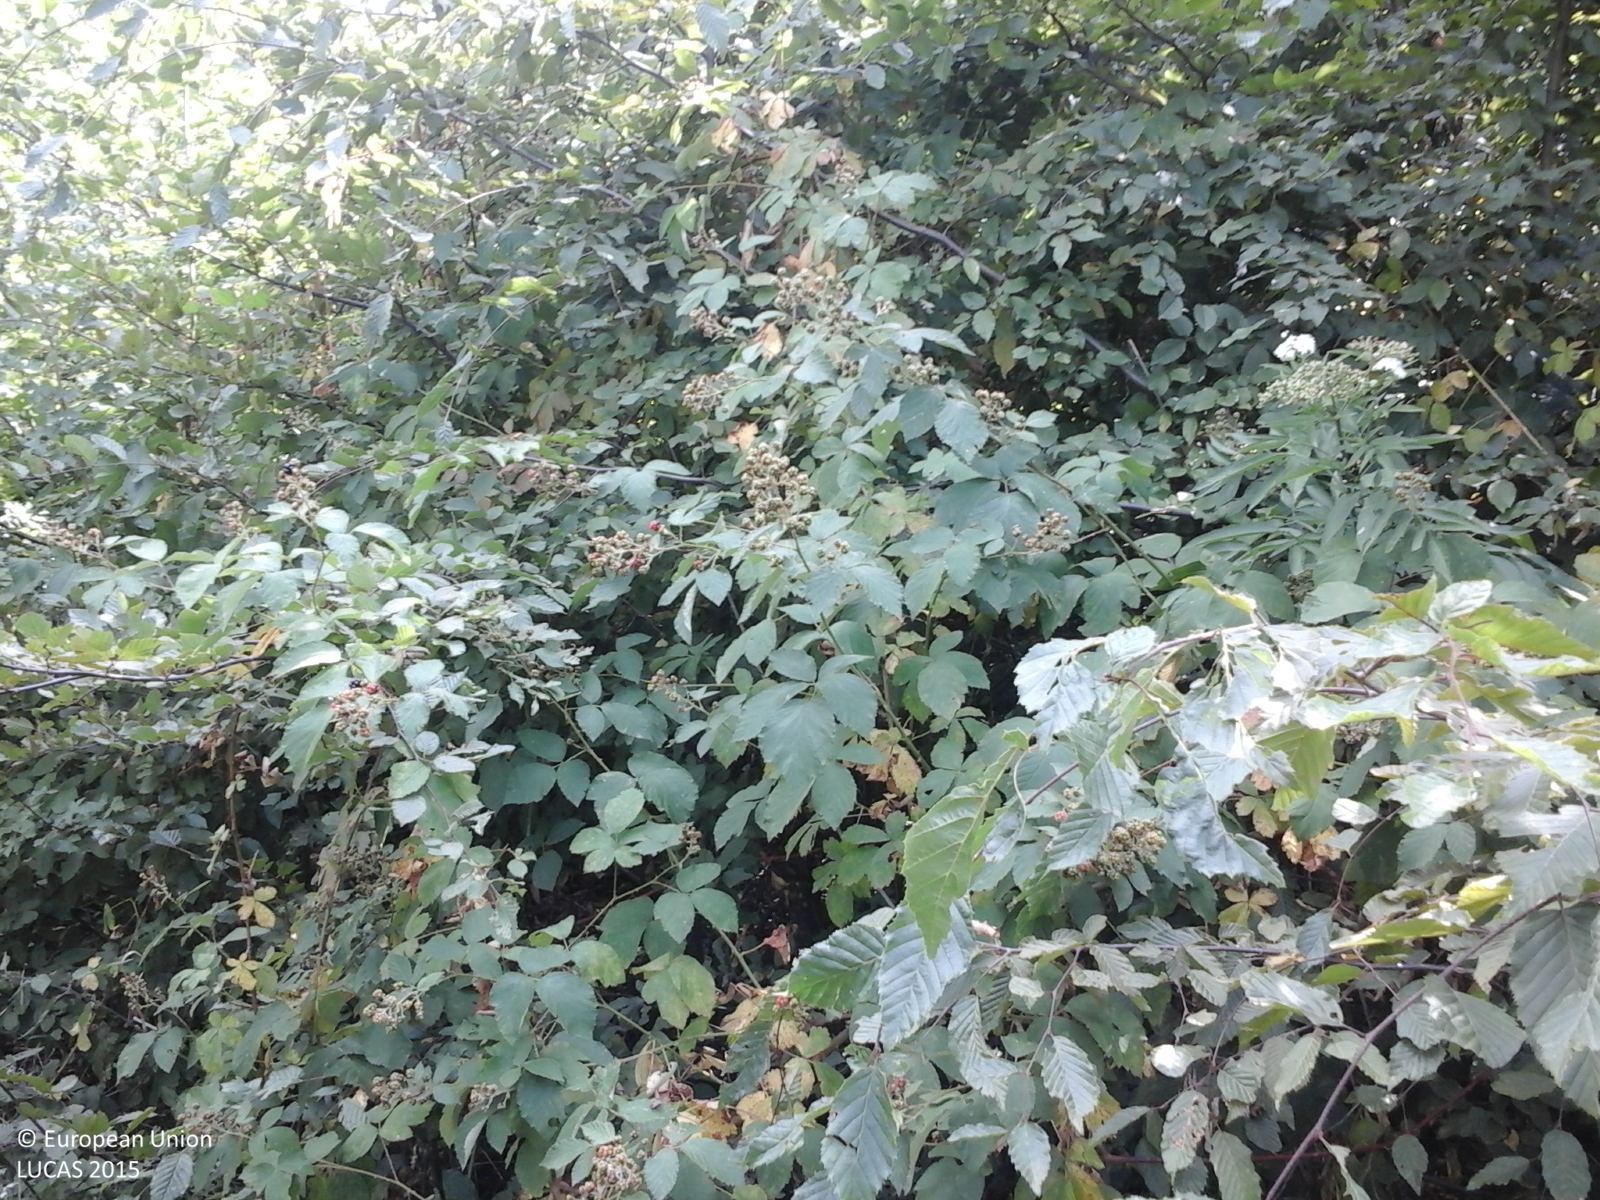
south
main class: Woodland
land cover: Broadleaved woodland
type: beech forest
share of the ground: > 75 %
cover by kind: broadleaved forest trees 100 %
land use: Forestry
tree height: < 5 m
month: July
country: RO
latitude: 46.3898
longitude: 27.3620
